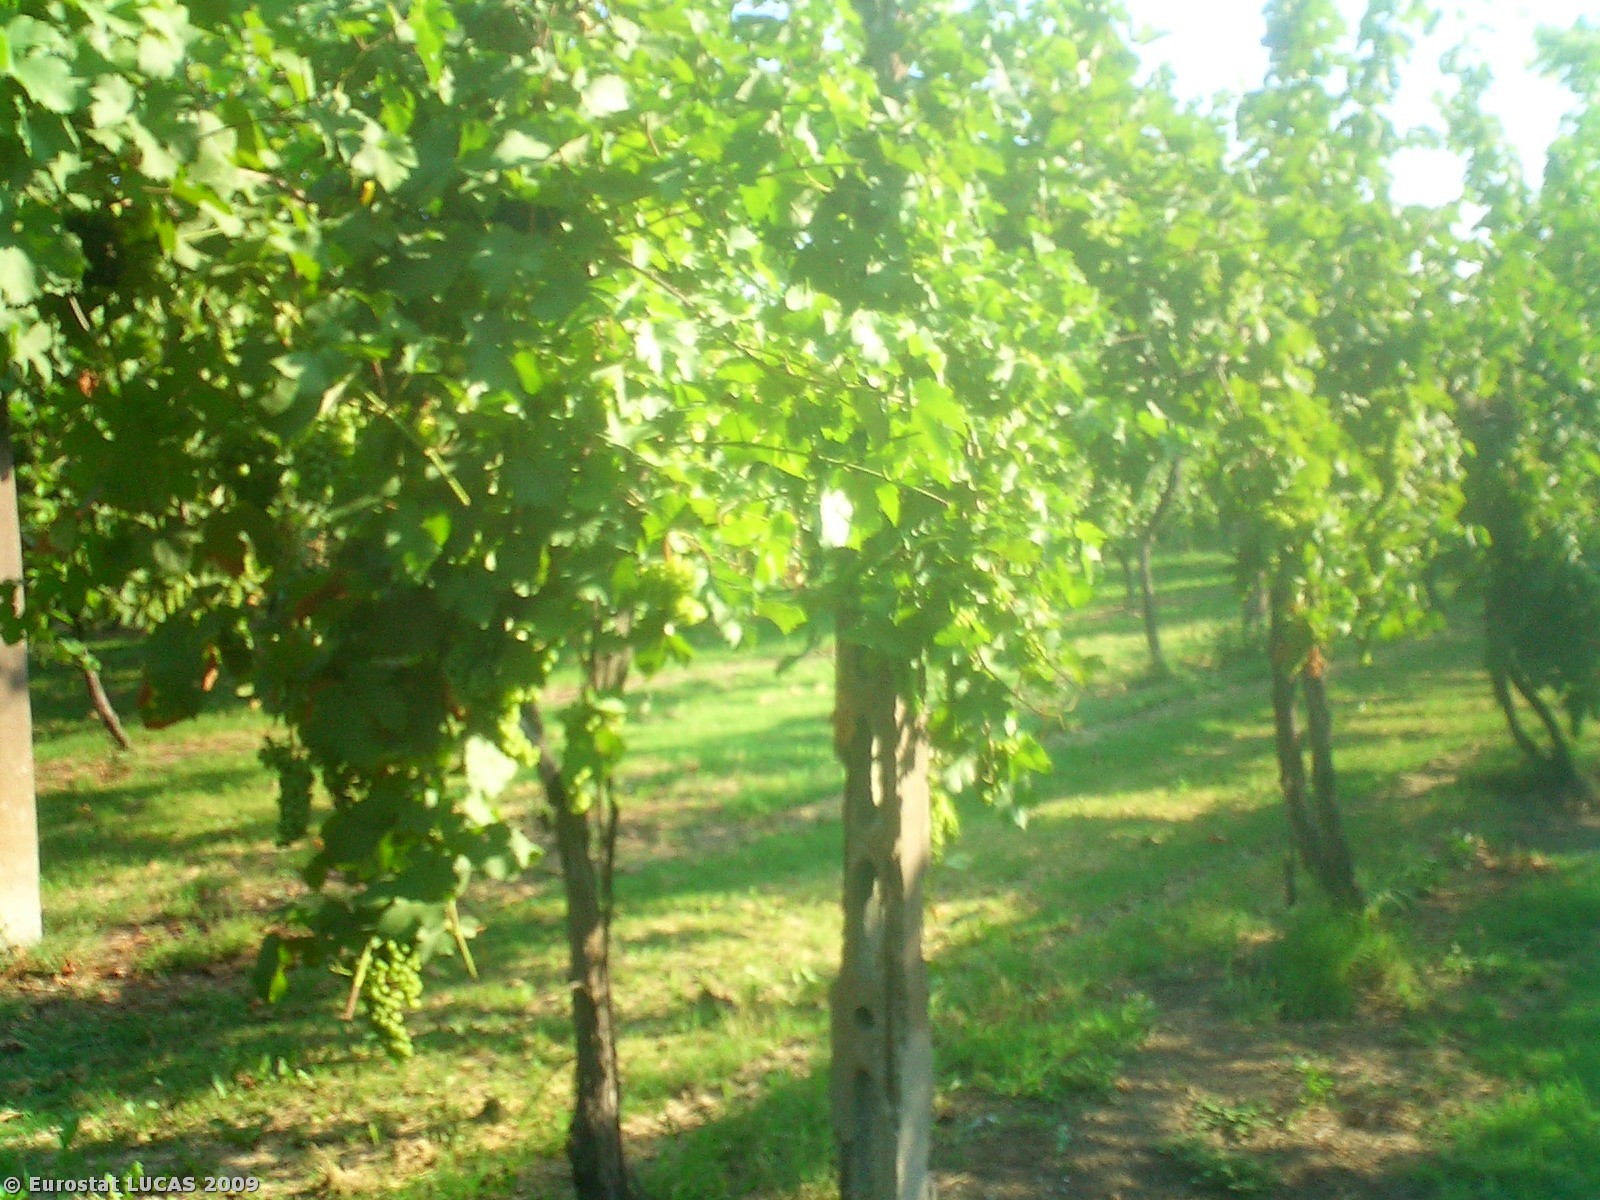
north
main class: Cropland
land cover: Vineyards
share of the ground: 50 - 75 %
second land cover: Grassland with sparse tree/shrub cover
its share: 50 - 75 %
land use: Agriculture (excluding fallow land and kitchen gardens)
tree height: < 5 m
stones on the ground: < 10 %
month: July
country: IT
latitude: 44.2959
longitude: 11.9634
